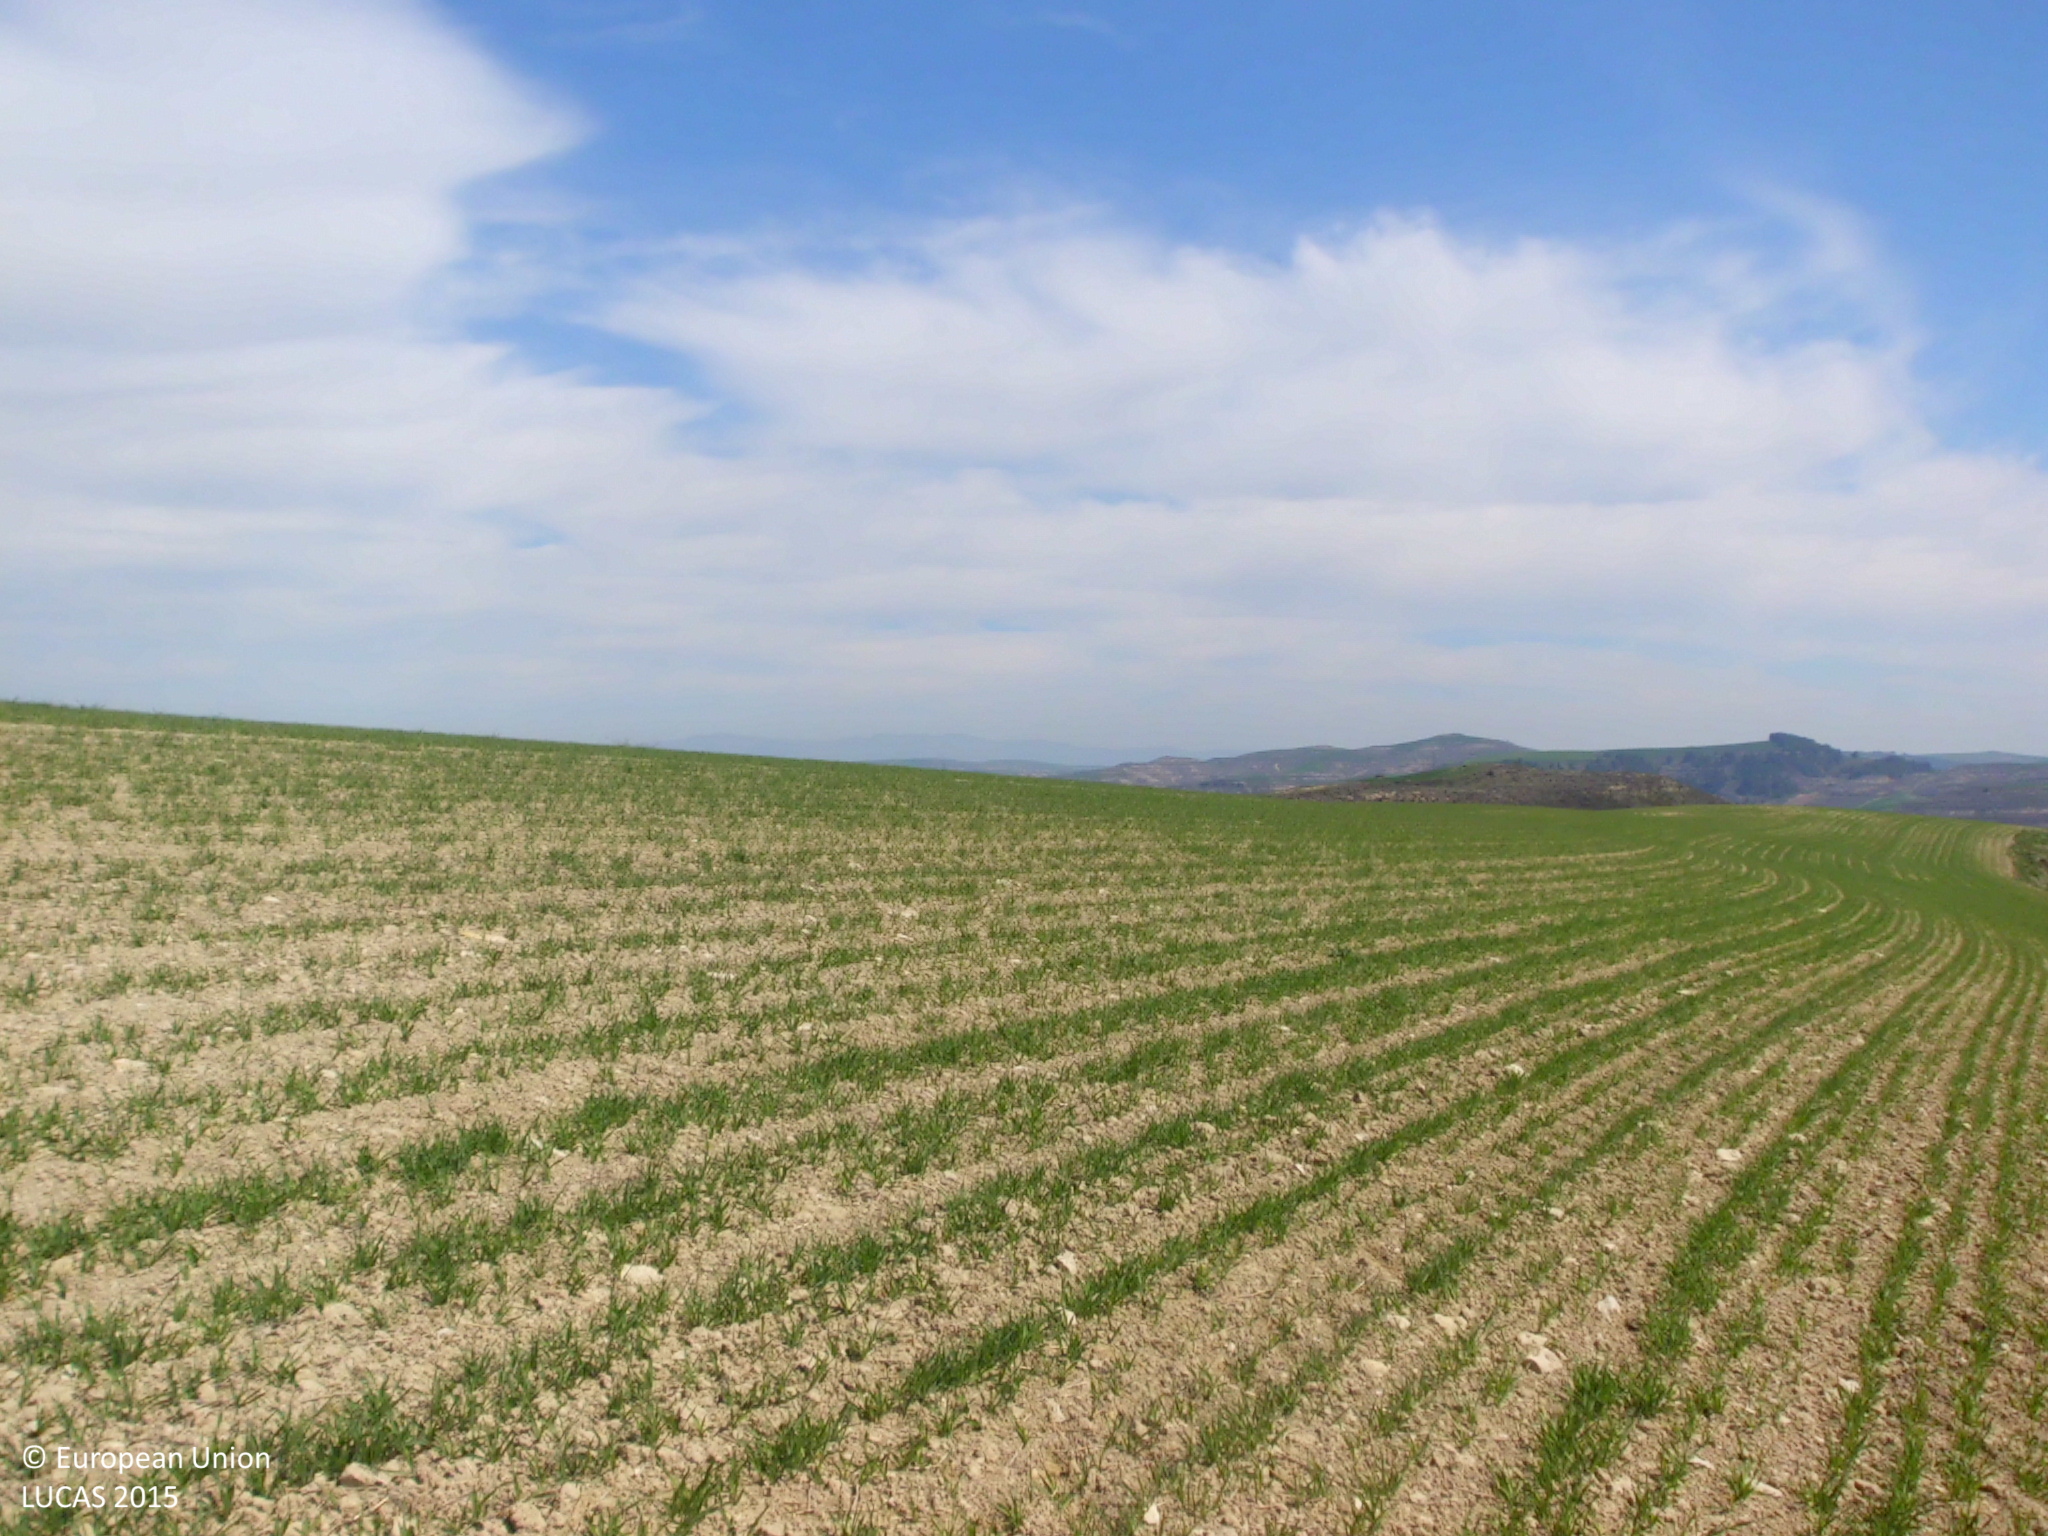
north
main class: Cropland
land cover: Barley
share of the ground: 10 - 25 %
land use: Agriculture (excluding fallow land and kitchen gardens)
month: April
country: ES
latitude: 42.4220
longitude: -3.3644
